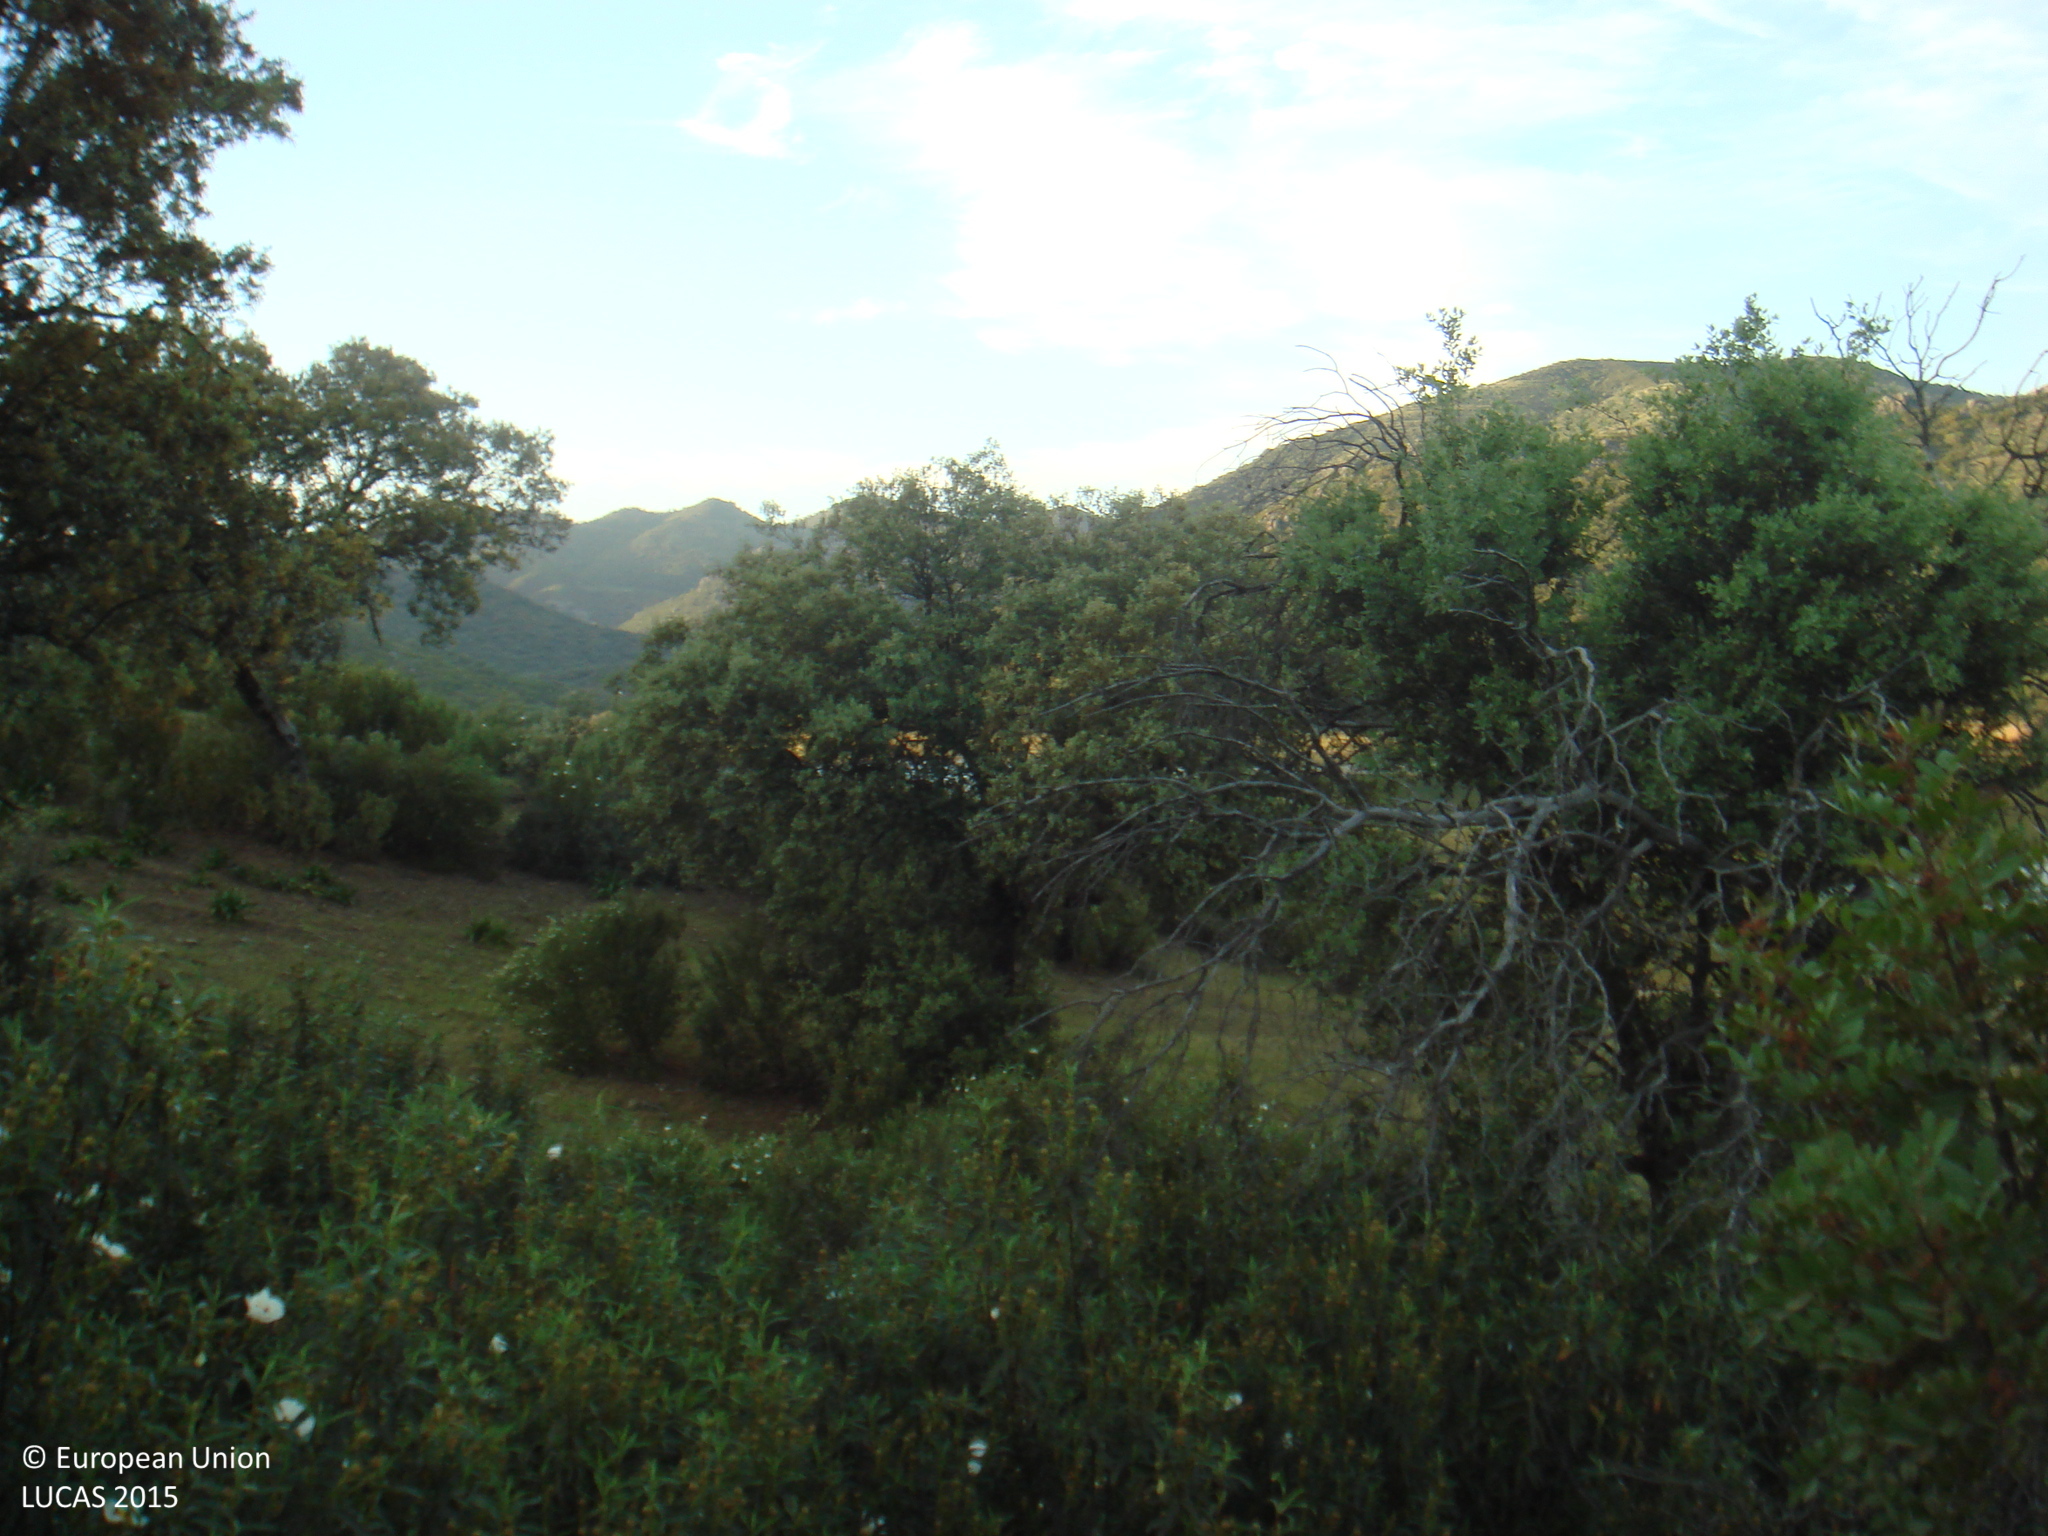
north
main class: Shrubland
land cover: Shrubland with sparse tree cover
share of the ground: 50 - 75 %
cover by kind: herbaceous plants 55 %, shrubs 40 %, broadleaved forest trees 5 %
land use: Forestry
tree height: > 5 m
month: April
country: ES
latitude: 38.0681
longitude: -4.7092
